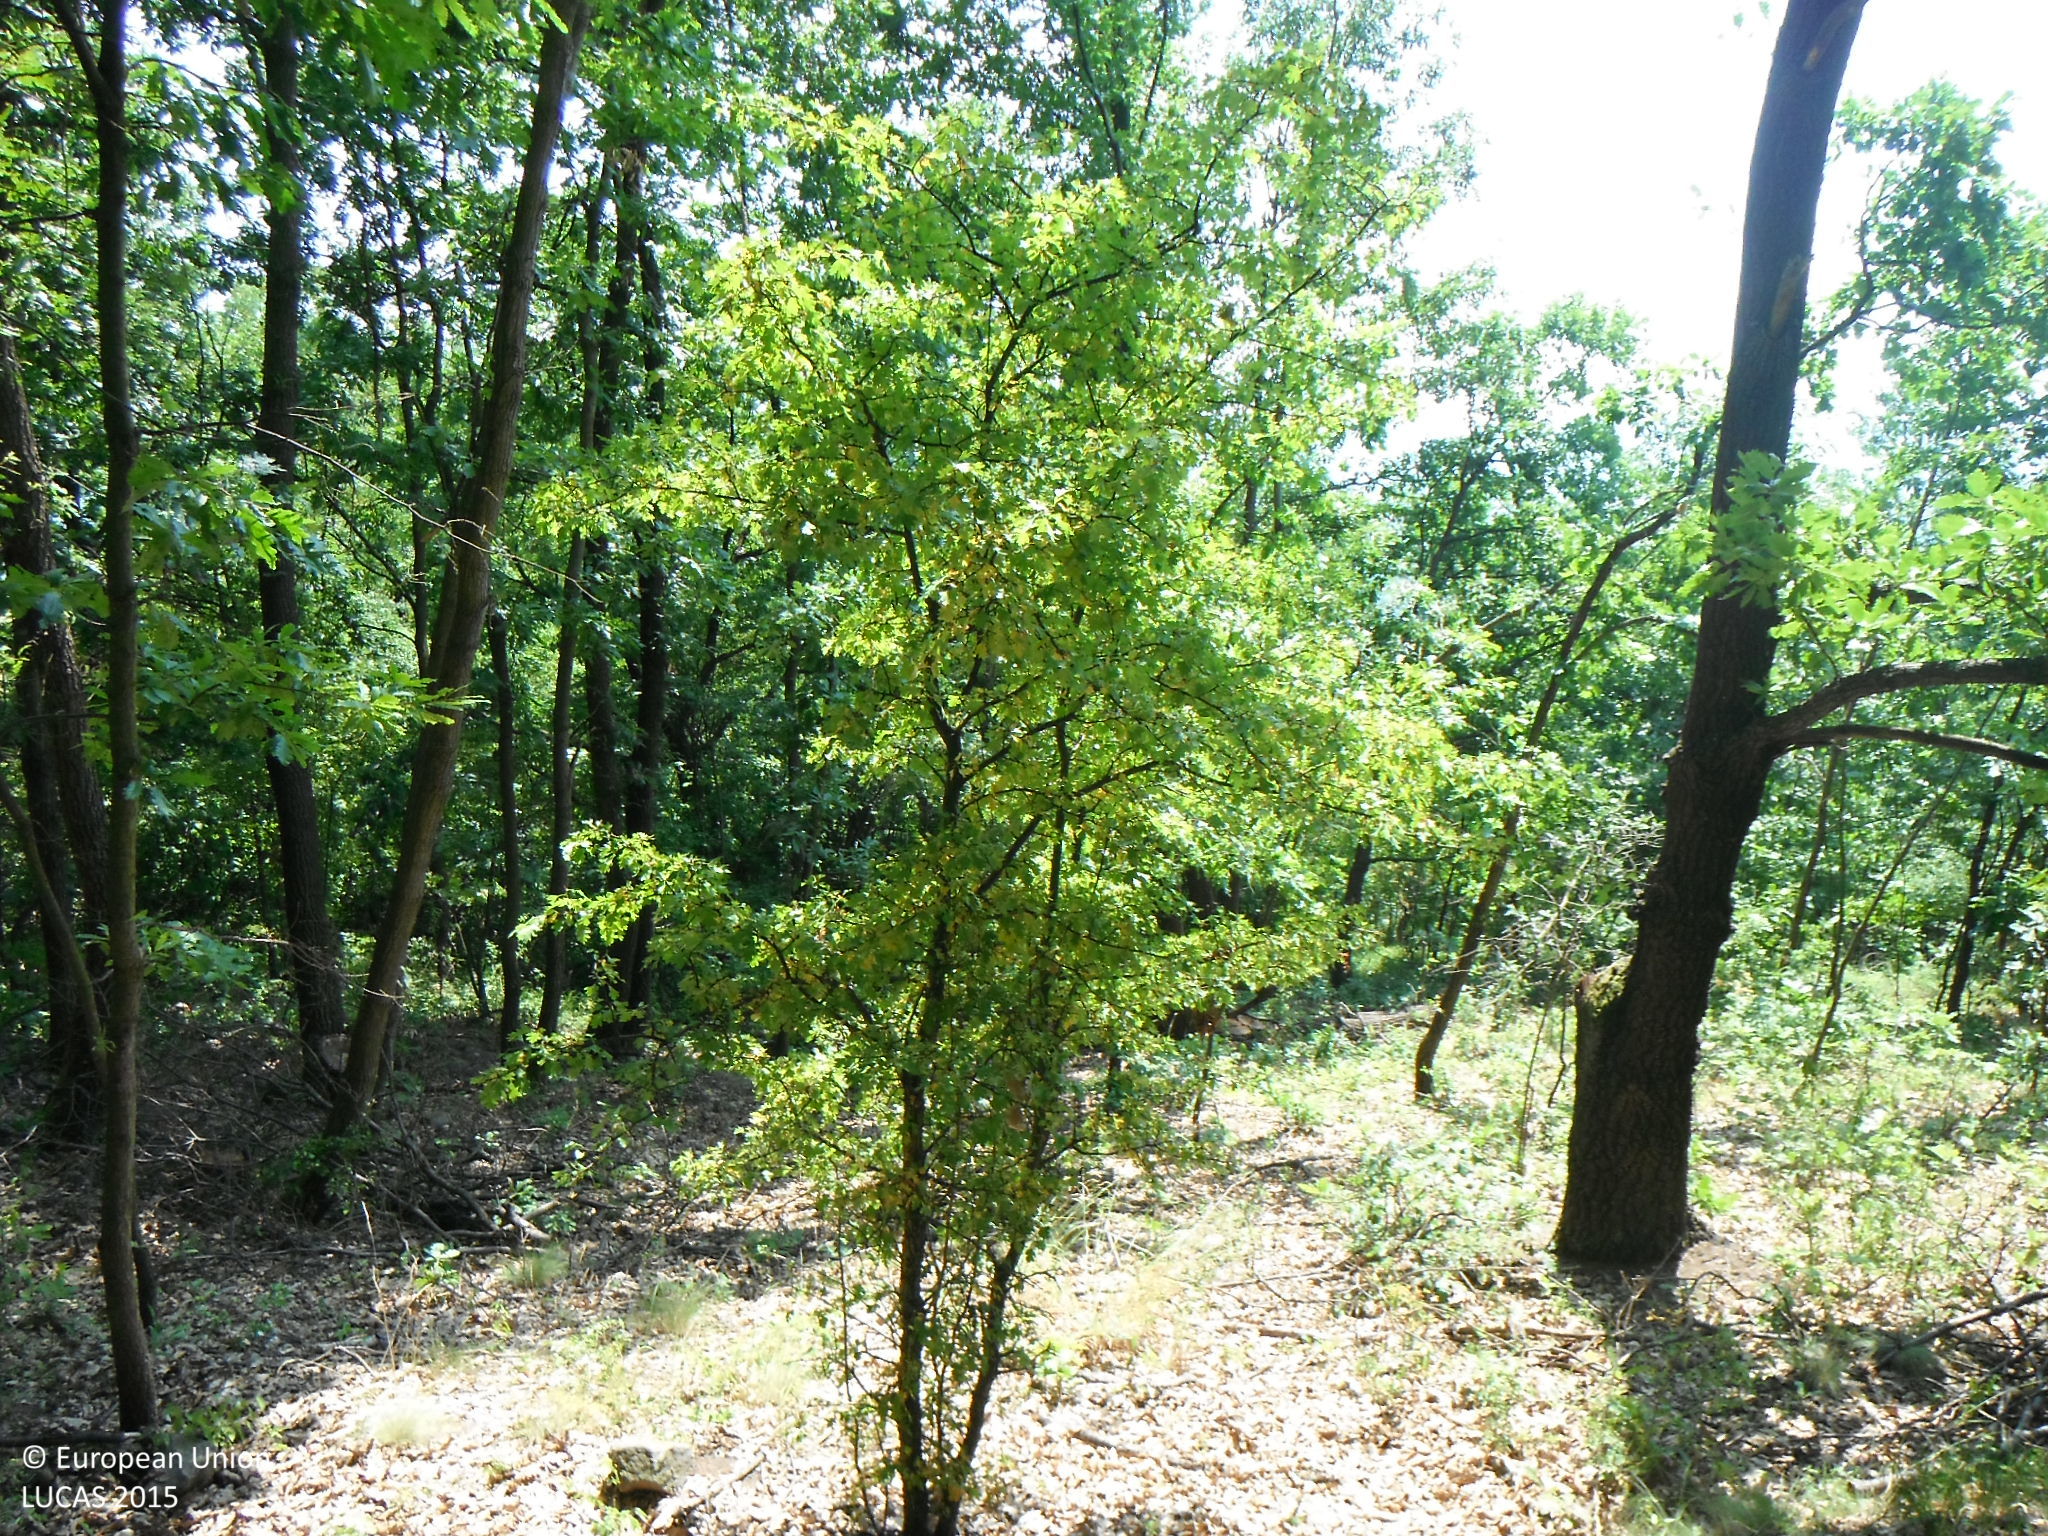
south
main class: Woodland
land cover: Broadleaved woodland
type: acidophilous oak and oak-birch forest
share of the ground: > 75 %
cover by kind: broadleaved forest trees 75 %, herbaceous plants 20 %, shrubs 5 %
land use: Forestry
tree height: > 5 m
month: July
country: SK
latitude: 48.0879
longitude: 19.0281
